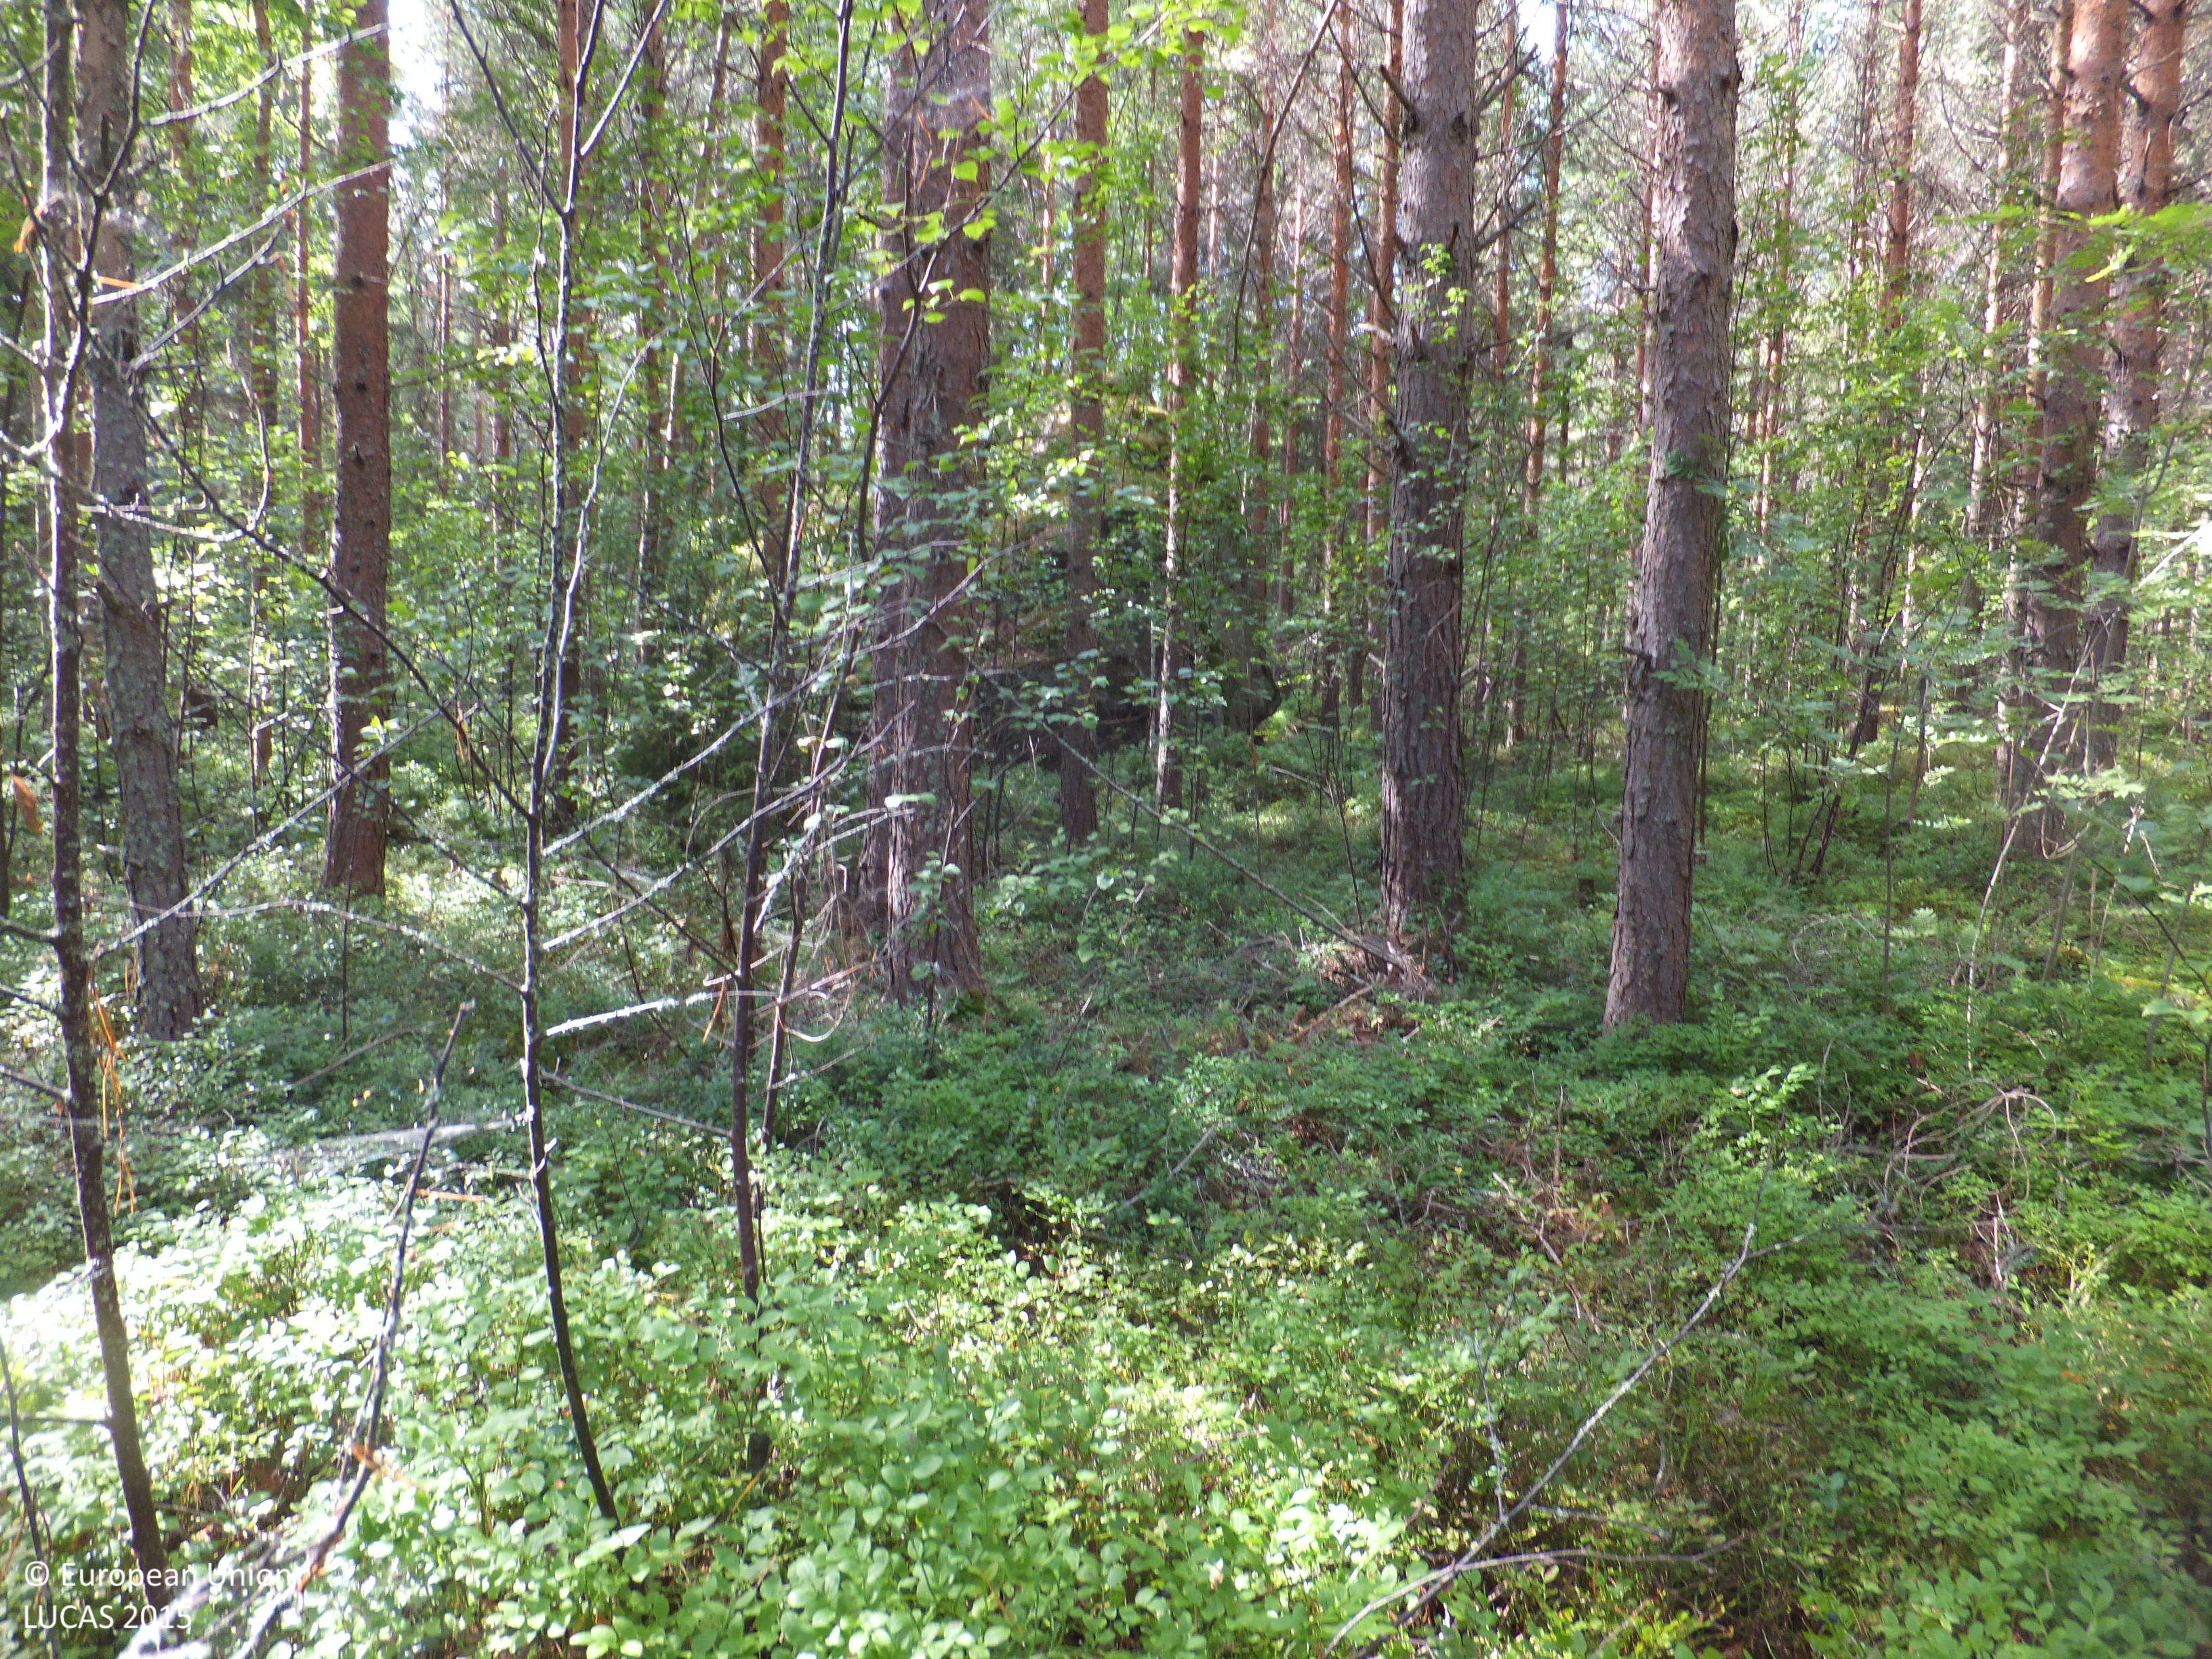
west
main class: Woodland
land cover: Pine dominated mixed woodland
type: boreal forest
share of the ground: > 75 %
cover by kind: coniferous forest trees 55 %, broadleaved forest trees 20 %, shrubs 15 %, lichens and mosses 10 %
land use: Forestry
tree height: > 5 m
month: July
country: FI
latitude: 63.1541
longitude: 21.5308
